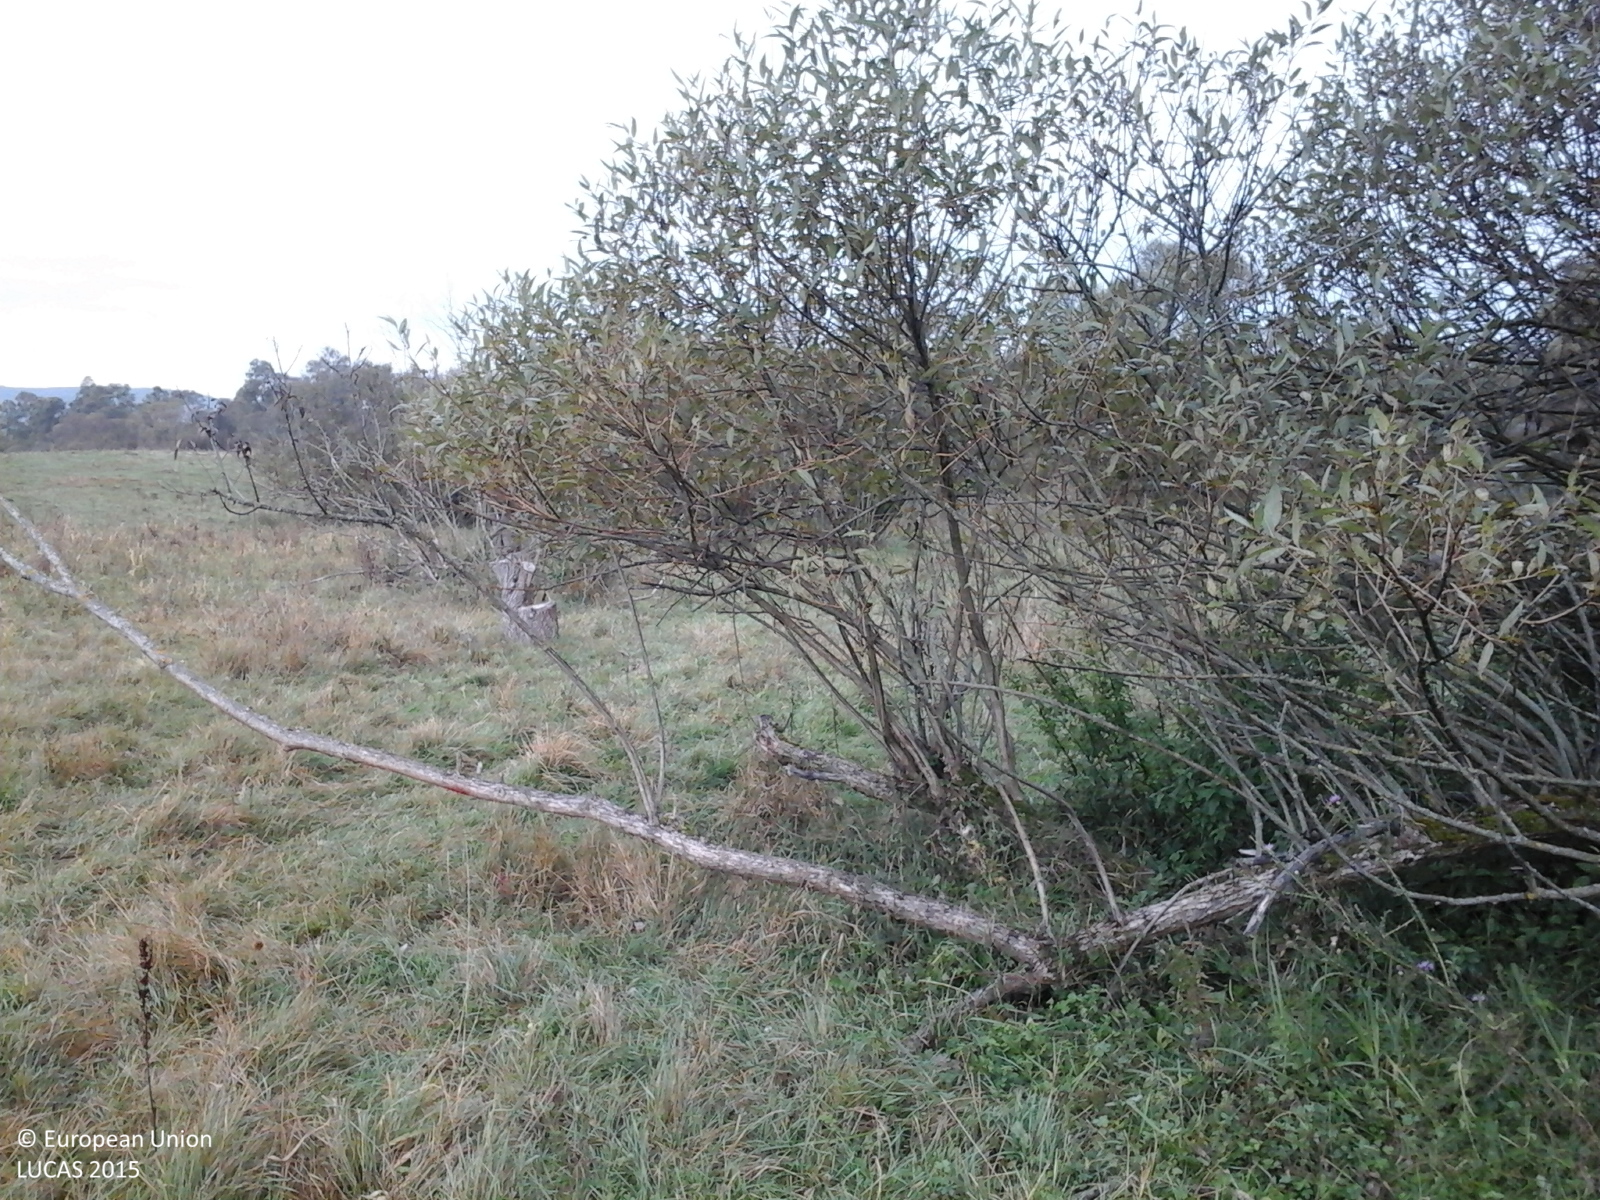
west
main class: Grassland
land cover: Grassland with sparse tree/shrub cover
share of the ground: > 75 %
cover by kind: herbaceous plants 95 %, broadleaved forest trees 5 %
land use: Agriculture (excluding fallow land and kitchen gardens)
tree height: > 5 m
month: October
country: RO
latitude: 46.0031
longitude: 24.7183
